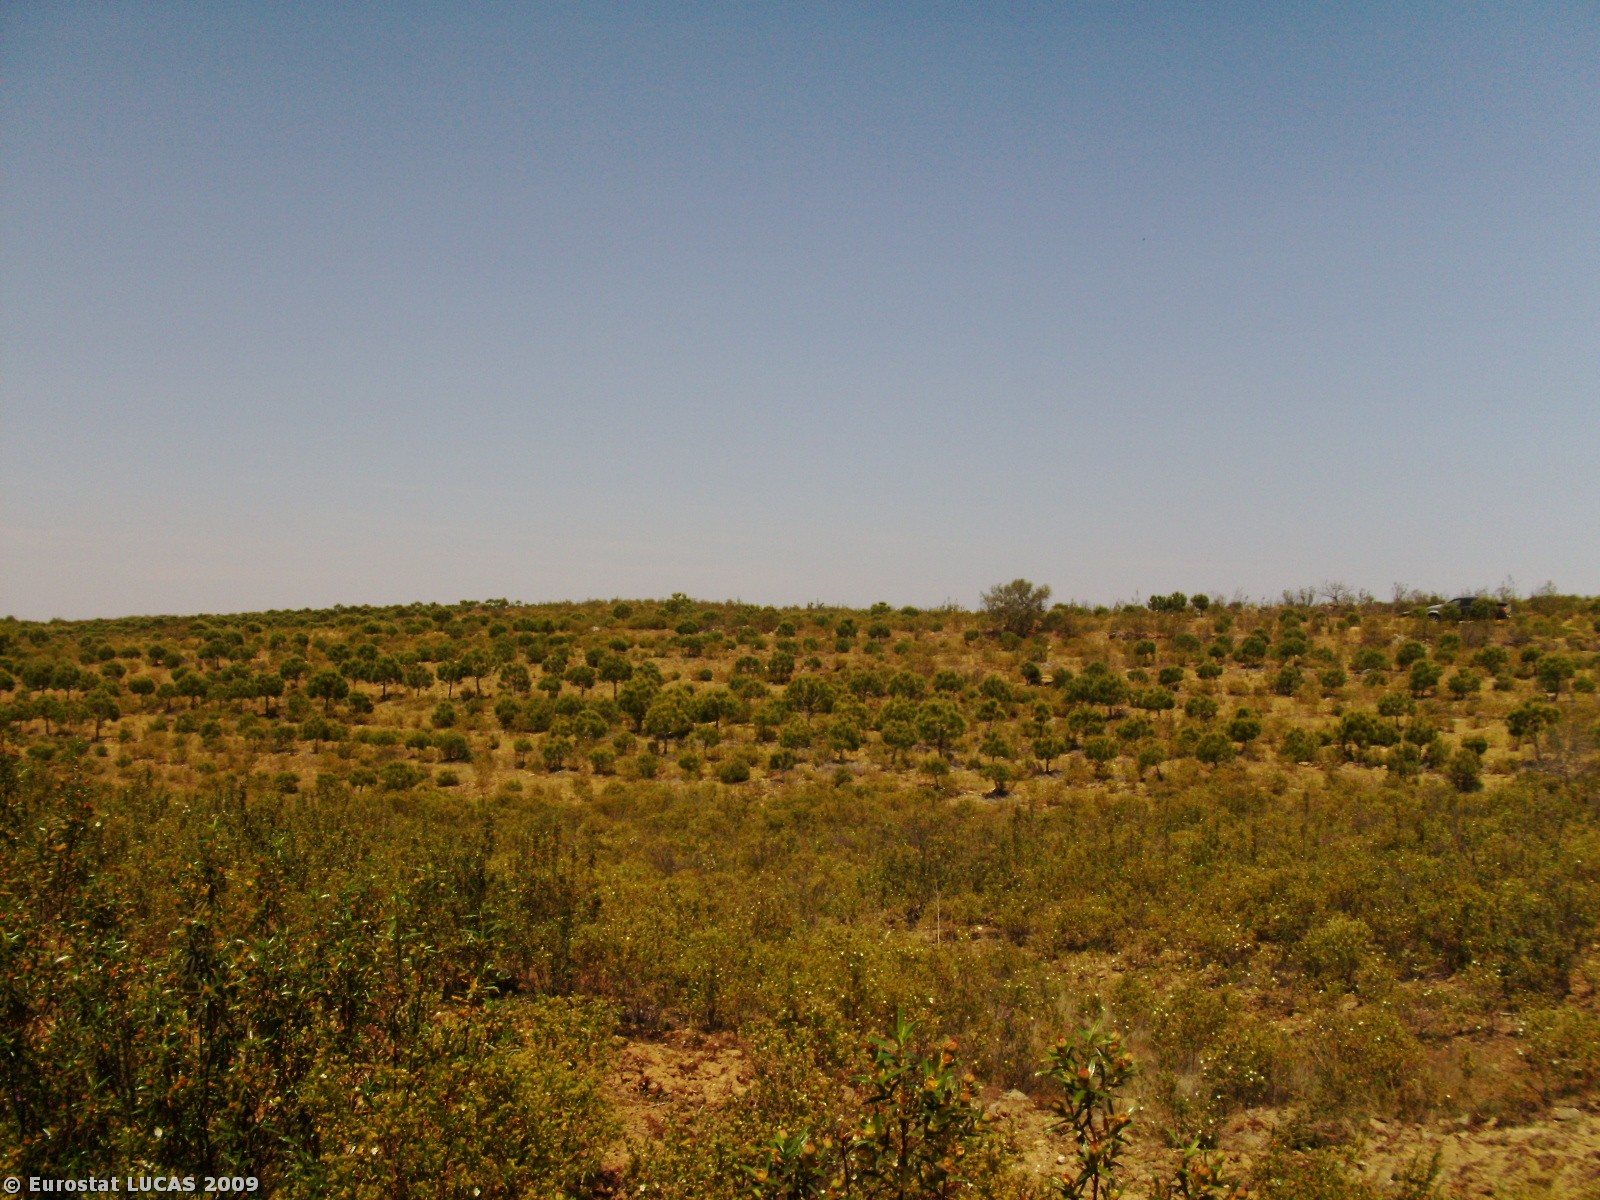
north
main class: Shrubland
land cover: Shrubland without tree cover
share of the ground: 50 - 75 %
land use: Unused
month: May
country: PT
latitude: 37.4356
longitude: -7.5379
